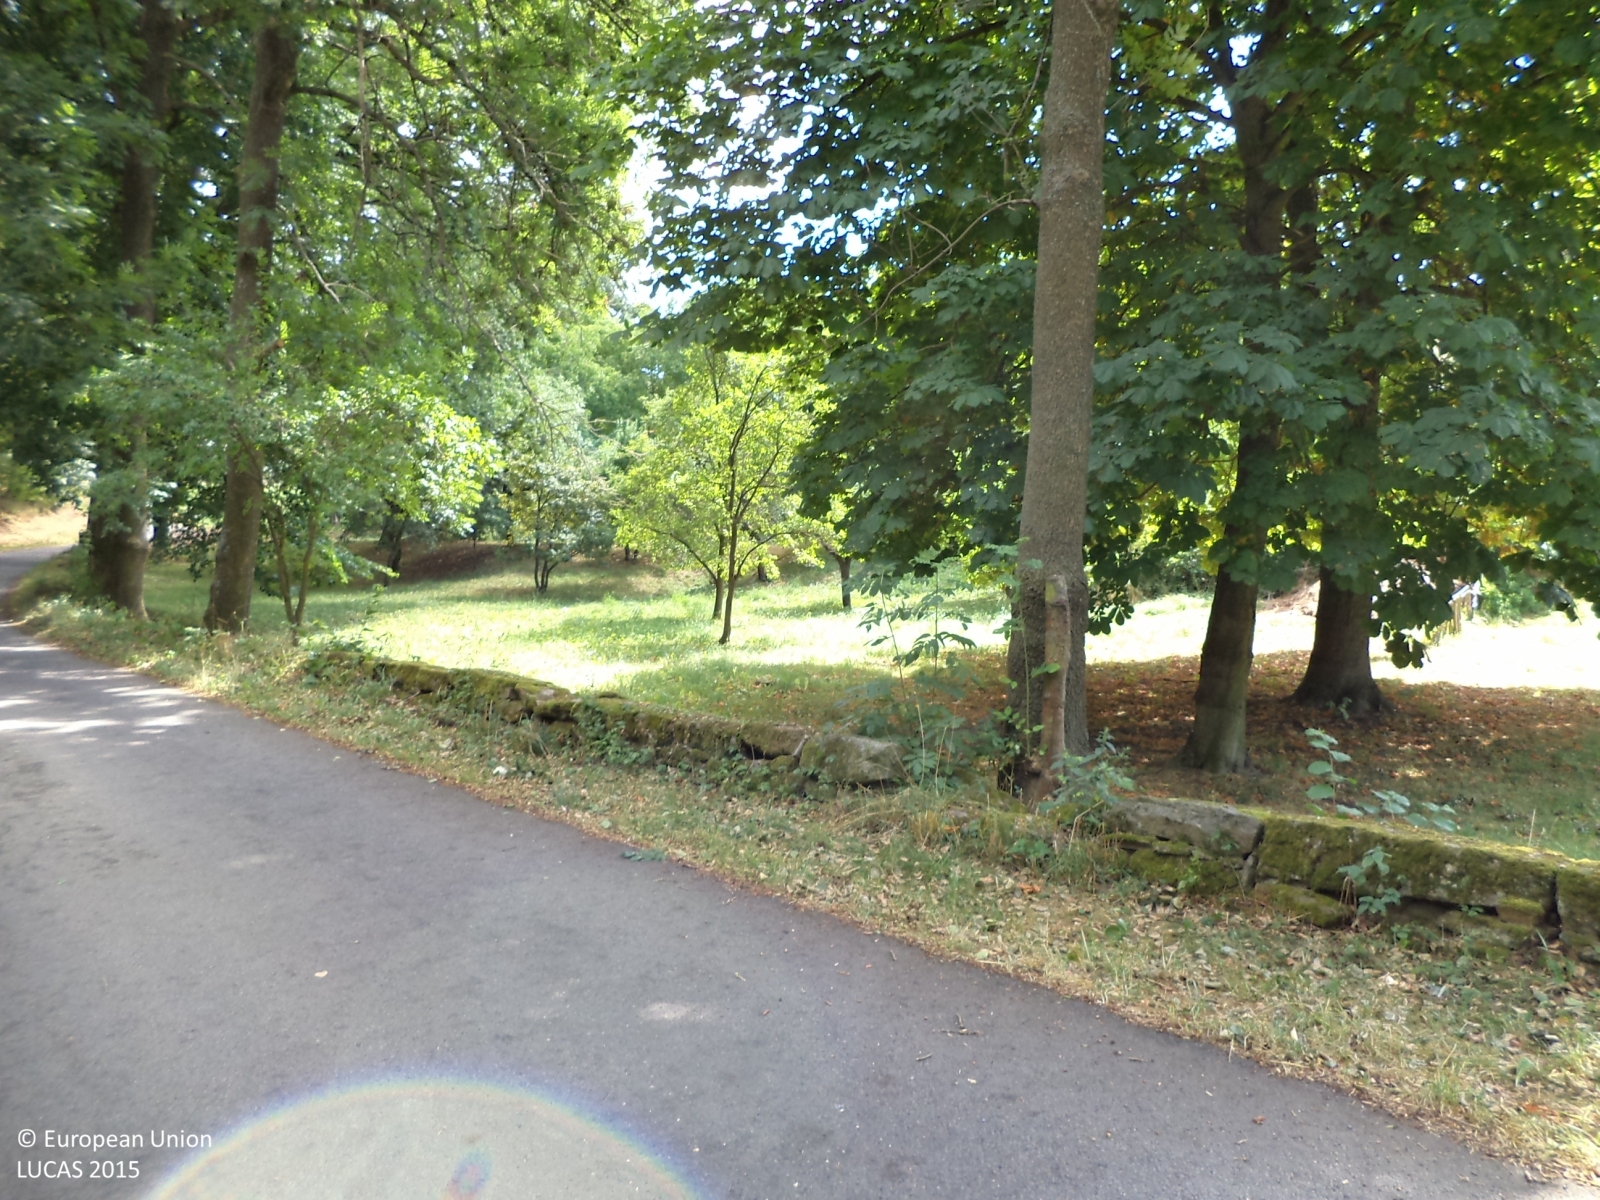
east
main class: Woodland
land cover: Broadleaved woodland
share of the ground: > 75 %
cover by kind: broadleaved forest trees 90 %, herbaceous plants 10 %
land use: Forestry
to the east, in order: Grass margins; Broadleaved woodland; Artificial constructions in urban areas
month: July
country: CZ
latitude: 49.6652
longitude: 14.4489
